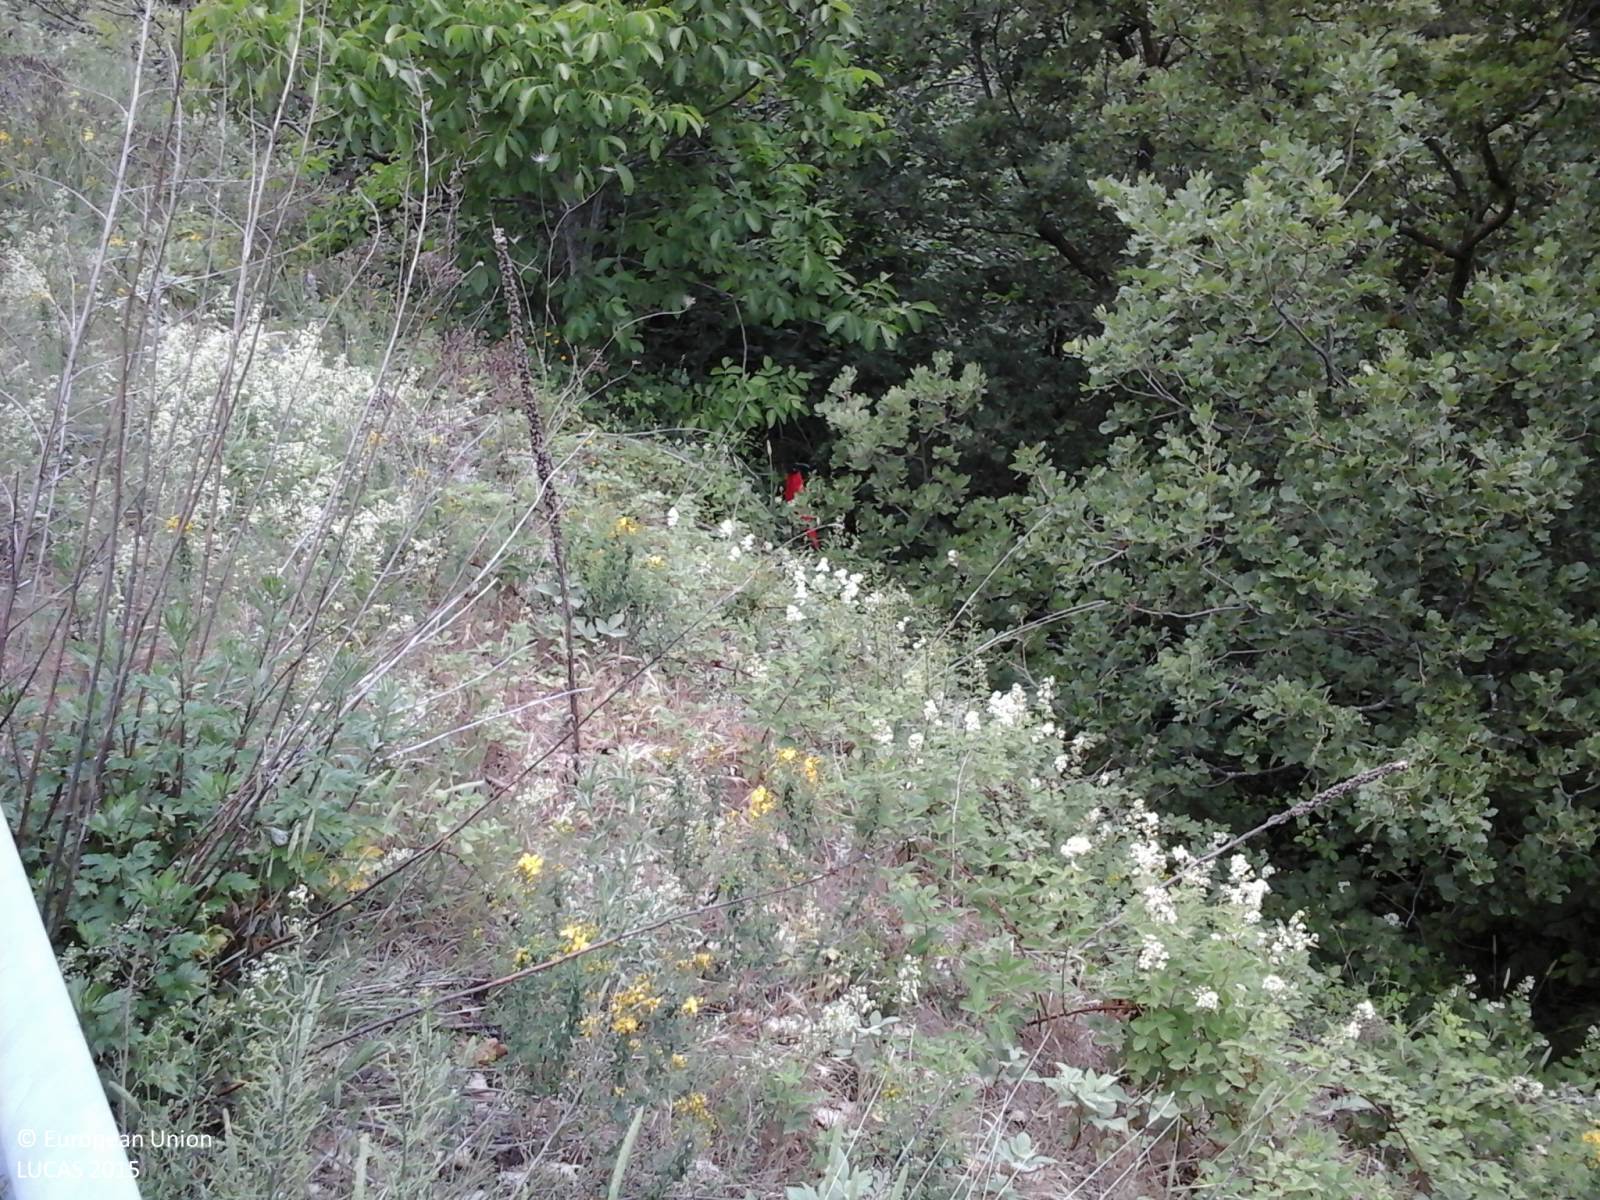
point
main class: Woodland
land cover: Broadleaved woodland
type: thermophilous deciduous forest
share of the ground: > 75 %
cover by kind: broadleaved forest trees 80 %, shrubs 20 %
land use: Semi-natural and natural areas not in use
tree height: > 5 m
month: June
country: IT
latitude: 42.0793
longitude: 13.7227
